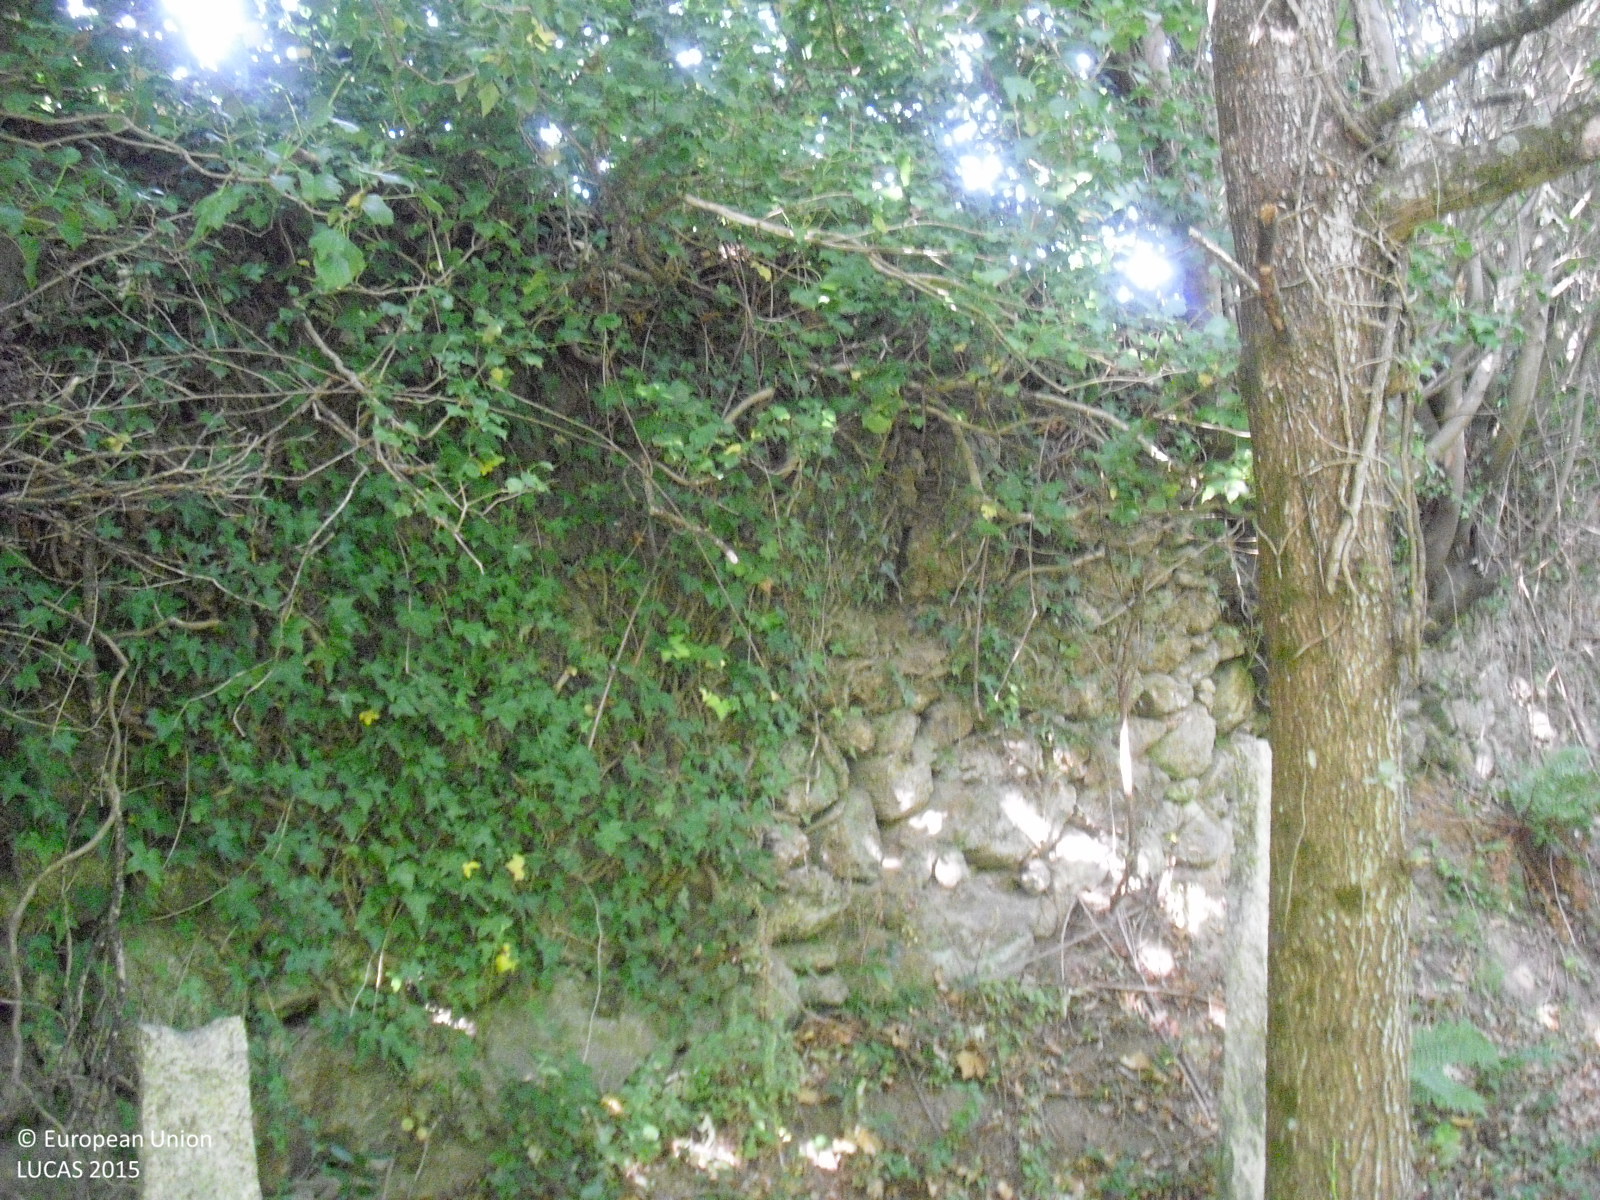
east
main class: Woodland
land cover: Broadleaved woodland
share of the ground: > 75 %
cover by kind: broadleaved forest trees 100 %
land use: Abandoned areas
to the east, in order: Broadleaved woodland; Dry stone walls; Grassland with sparse tree/shrub cover; Dry stone walls; Fences; Vineyards; Other fresh vegetables; Potatoes; Vineyards; Fences; Spontaneously vegetated surfaces; Tracks; Fences; Nuts trees; Tracks; Ditches and canals; Electric lines; Dry stone walls; Grassland with sparse tree/shrub cover; Electric lines; Grassland with sparse tree/shrub cover; Fences; Grassland with sparse tree/shrub cover; Dry stone walls; Tracks; Electric lines; Tracks; Dry stone walls; Single bushes/trees; Grassland without tree/shrub cover; Dry stone walls; Shruby margins; Paved roads, cycling and walking lanes; Electric lines; Paved roads, cycling and walking lanes; Ditches and canals; Pine dominated coniferous woodland; Tracks; Dry stone walls; Pine dominated mixed woodland; Rock outcrops; Pine dominated mixed woodland
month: June
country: ES
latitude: 42.1169
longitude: -8.1895
